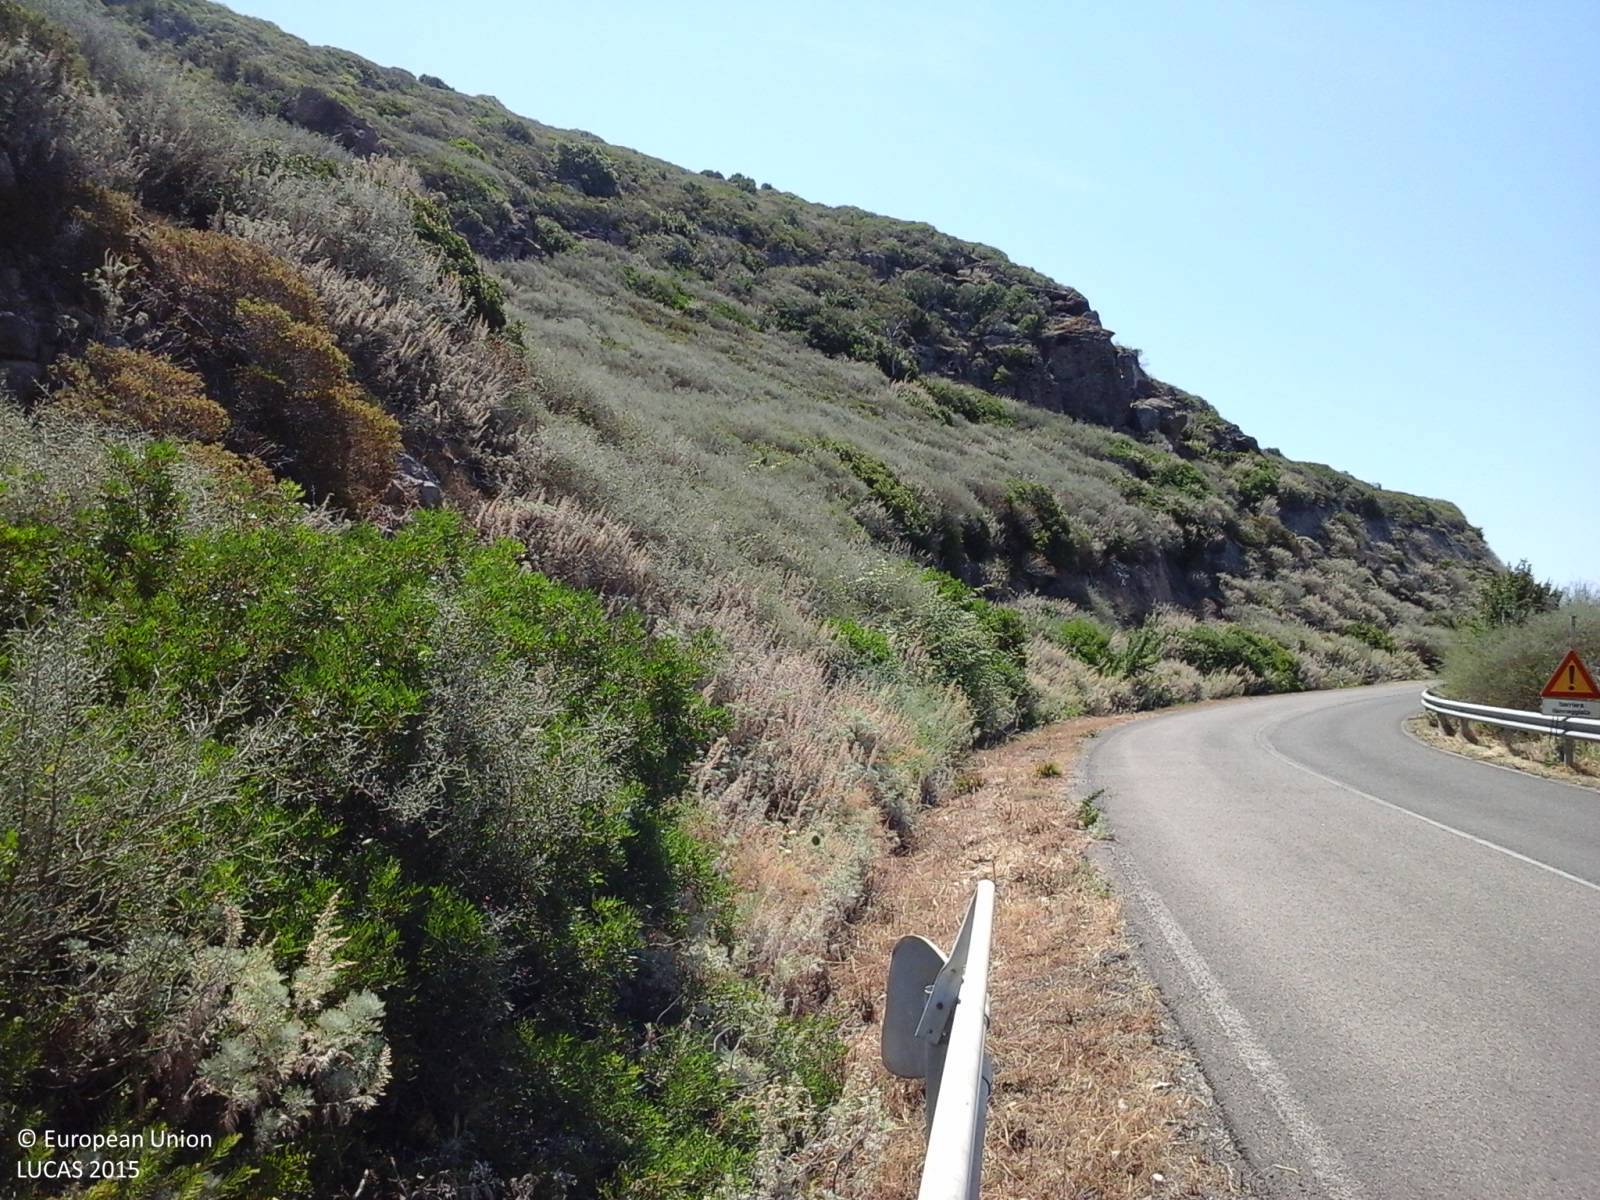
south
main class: Shrubland
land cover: Shrubland without tree cover
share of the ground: > 75 %
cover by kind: shrubs 90 %, consolidated bare surface 10 %
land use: Semi-natural and natural areas not in use
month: June
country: IT
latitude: 40.4533
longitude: 8.3926
